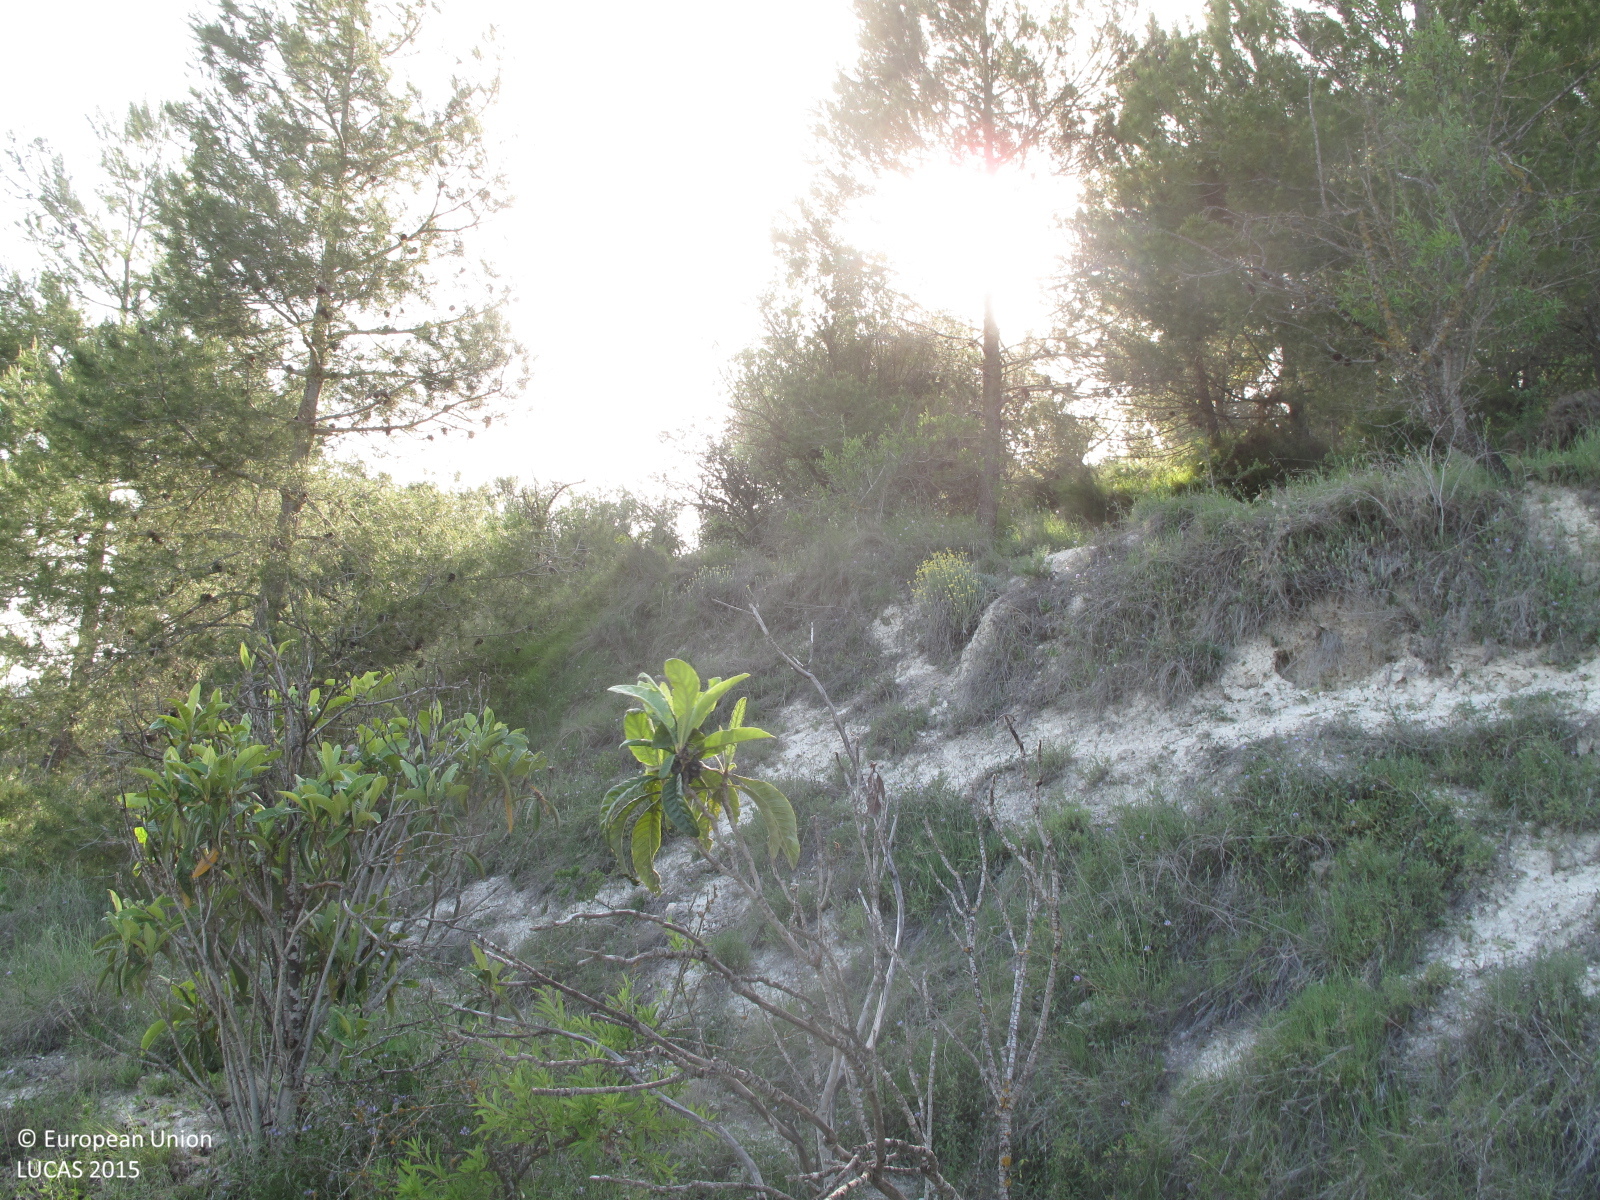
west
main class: Shrubland
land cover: Shrubland with sparse tree cover
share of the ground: 25 - 50 %
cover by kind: herbaceous plants 40 %, shrubs 35 %, consolidated bare surface 20 %, broadleaved forest trees 5 %
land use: Semi-natural and natural areas not in use
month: May
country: ES
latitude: 38.8030
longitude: -0.5499
